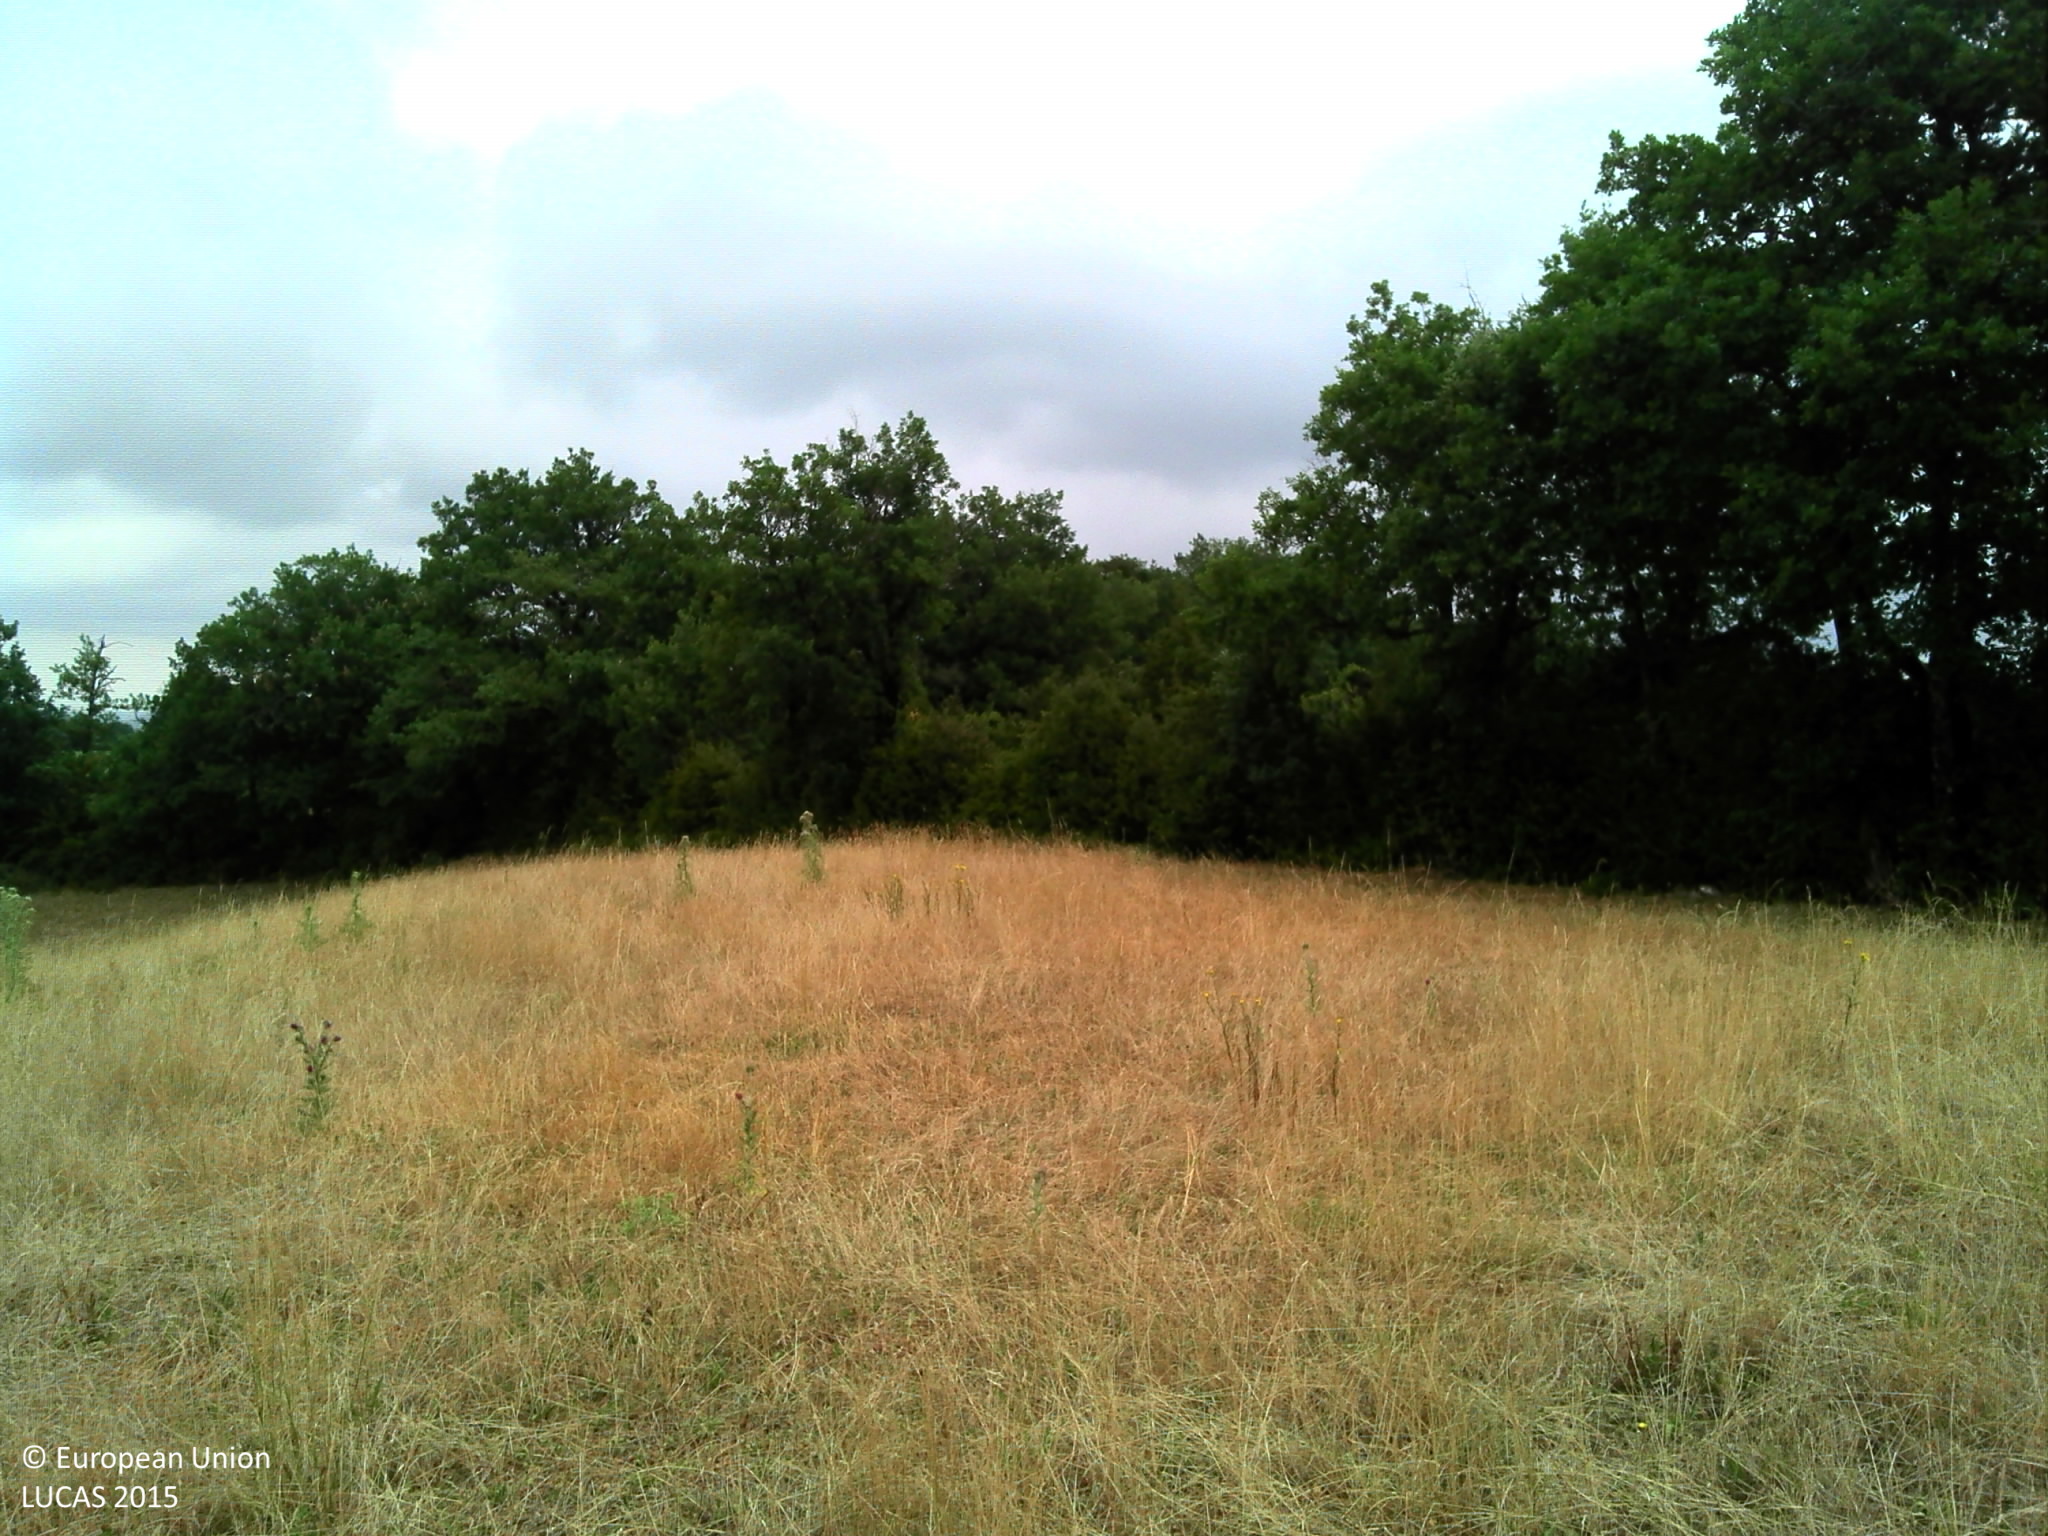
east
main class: Grassland
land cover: Grassland without tree/shrub cover
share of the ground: > 75 %
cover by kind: herbaceous plants 95 %, shrubs 5 %
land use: Agriculture (excluding fallow land and kitchen gardens)
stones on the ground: 25 - 50 %
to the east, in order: Grassland without tree/shrub cover; Broadleaved woodland; Fences; Grass margins; Tracks; Abandoned hedges; Fences; Grassland without tree/shrub cover
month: July
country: FR
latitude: 44.4076
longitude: 3.0605
